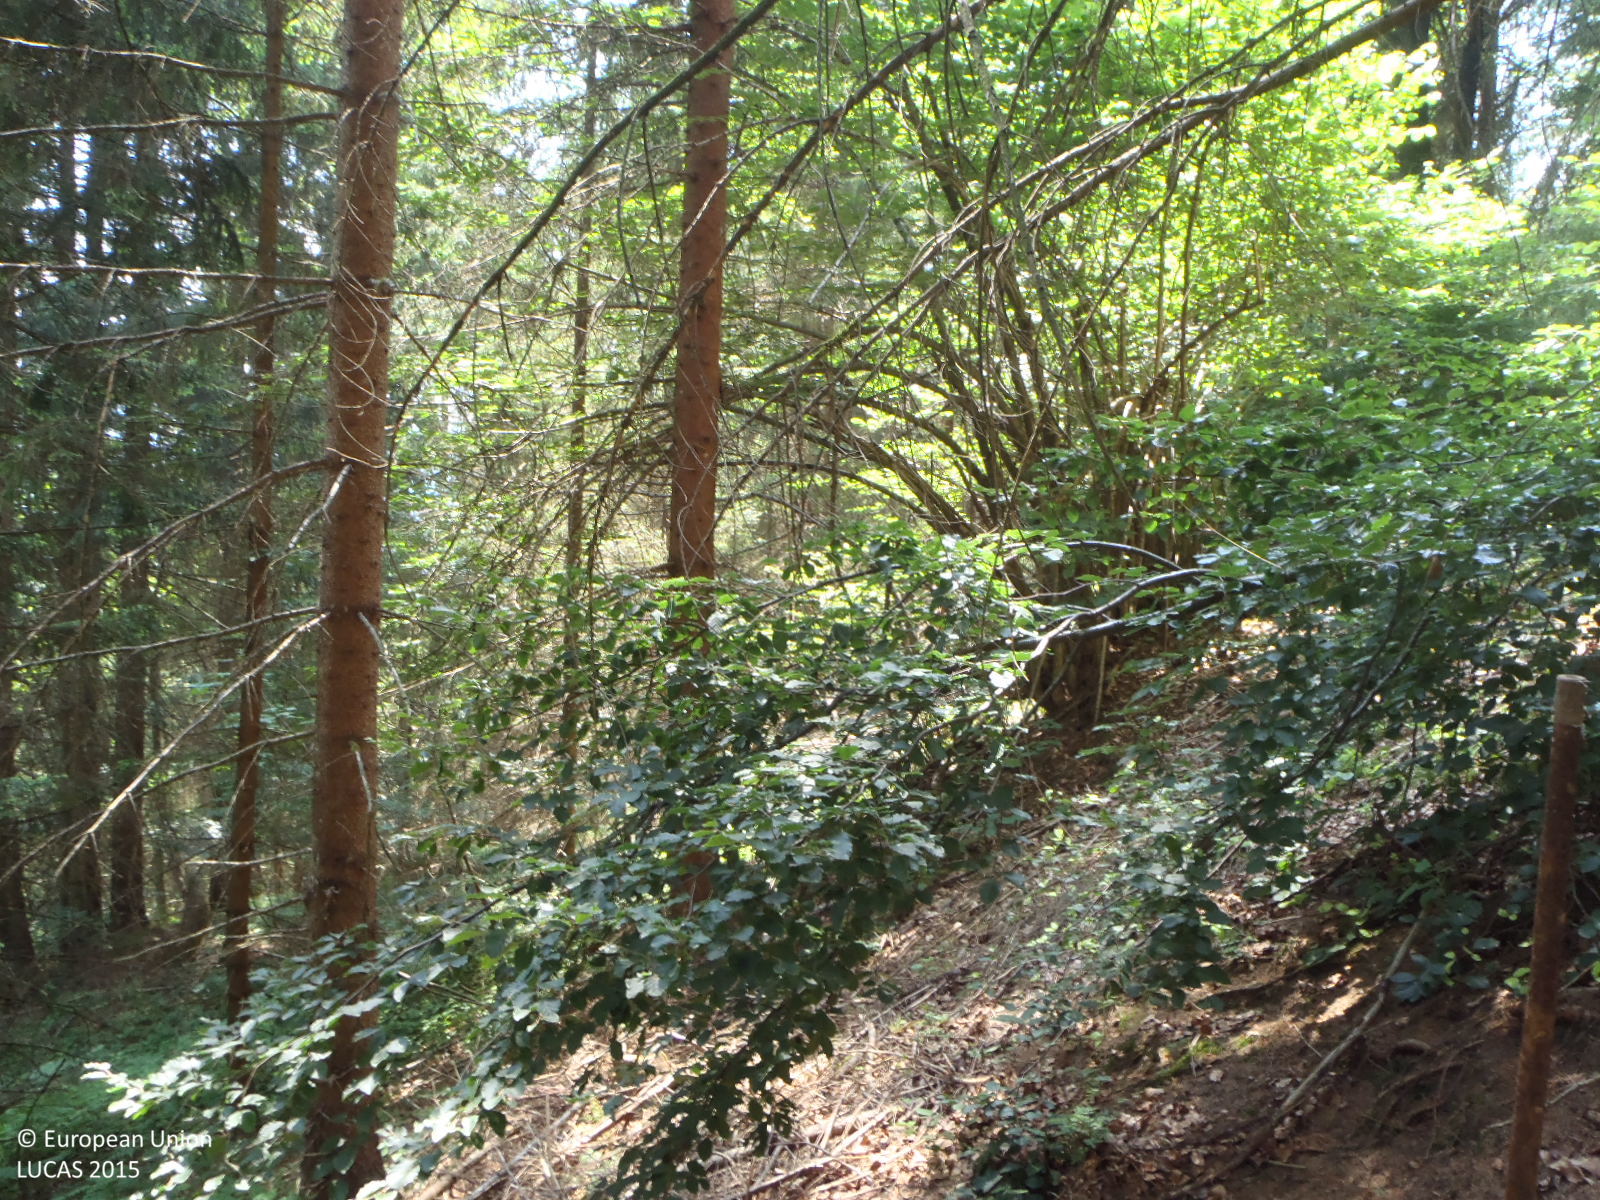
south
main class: Woodland
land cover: Spruce dominated coniferous woodland
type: alpine coniferous forest
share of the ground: > 75 %
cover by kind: coniferous forest trees 85 %, herbaceous plants 10 %, lichens and mosses 5 %
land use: Forestry
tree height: > 5 m
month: July
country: AT
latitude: 47.5486
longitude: 12.4300
